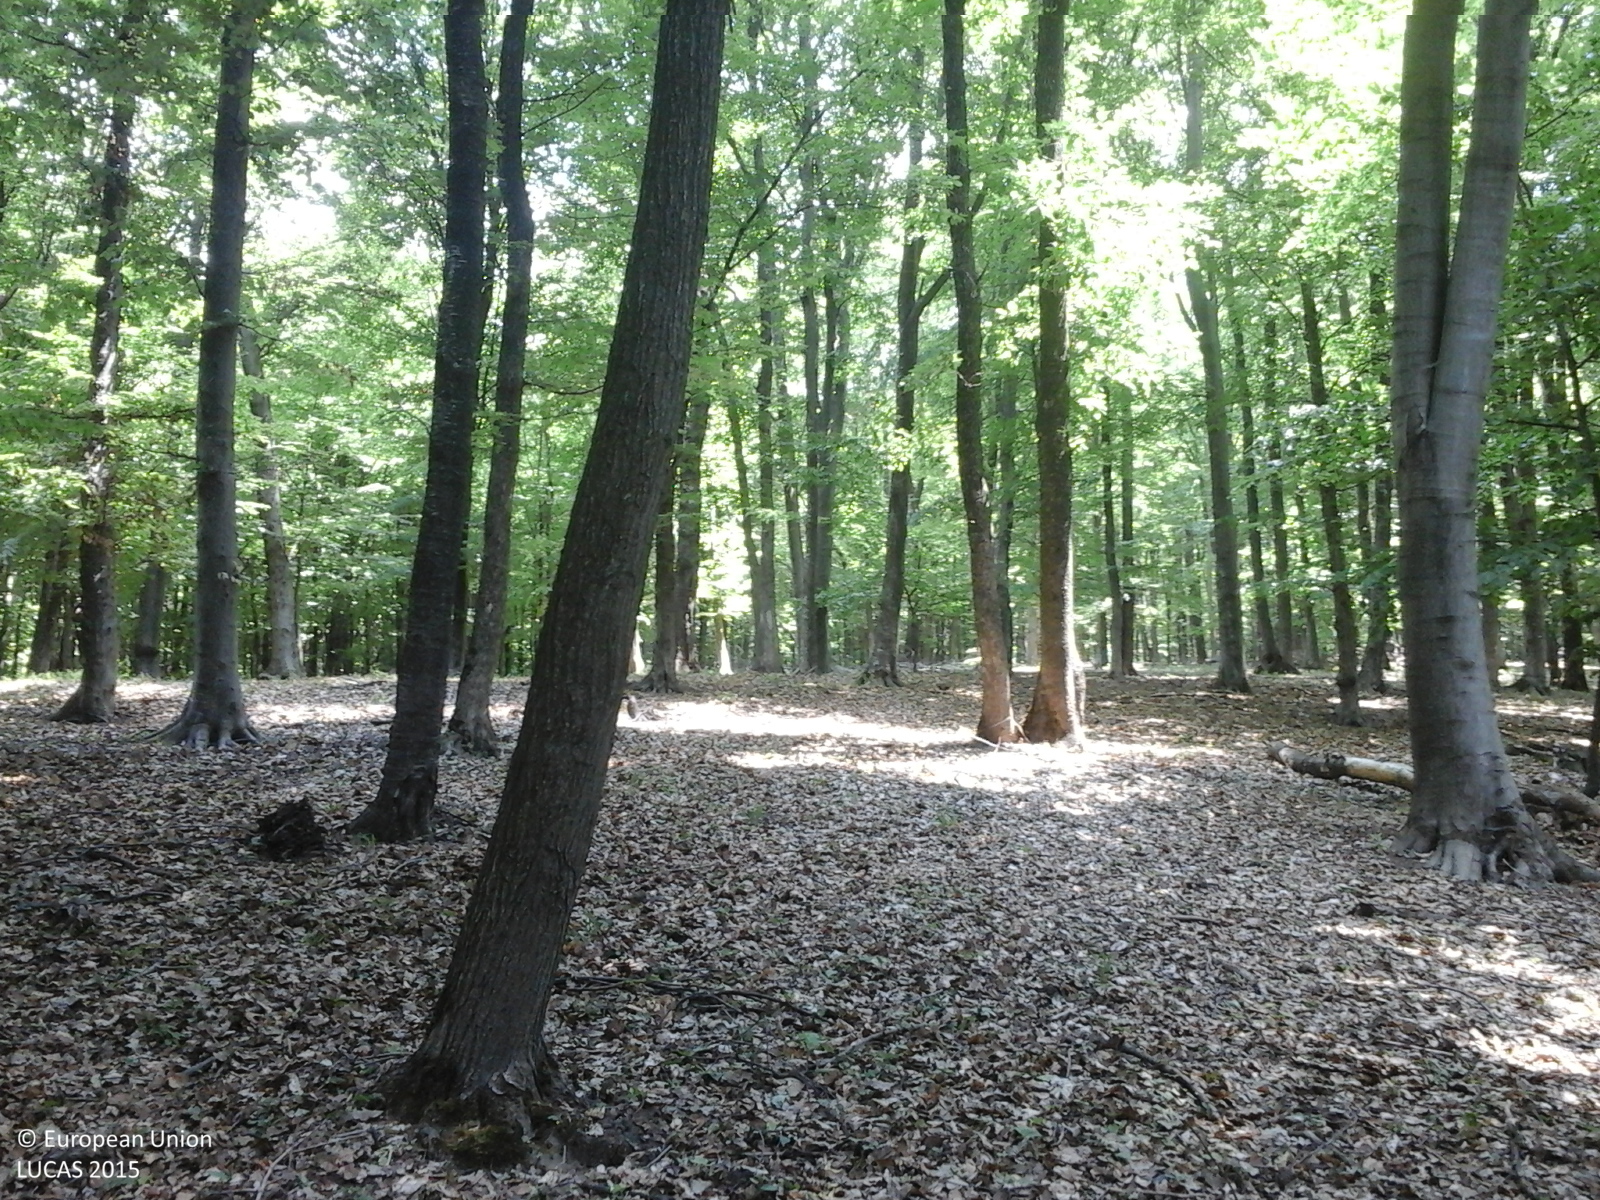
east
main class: Woodland
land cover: Broadleaved woodland
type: mesophytic deciduous forest
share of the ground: > 75 %
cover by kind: broadleaved forest trees 100 %
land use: Forestry
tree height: > 5 m
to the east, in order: Broadleaved woodland; Tracks; Broadleaved woodland
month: June
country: RO
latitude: 46.4057
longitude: 27.1528
